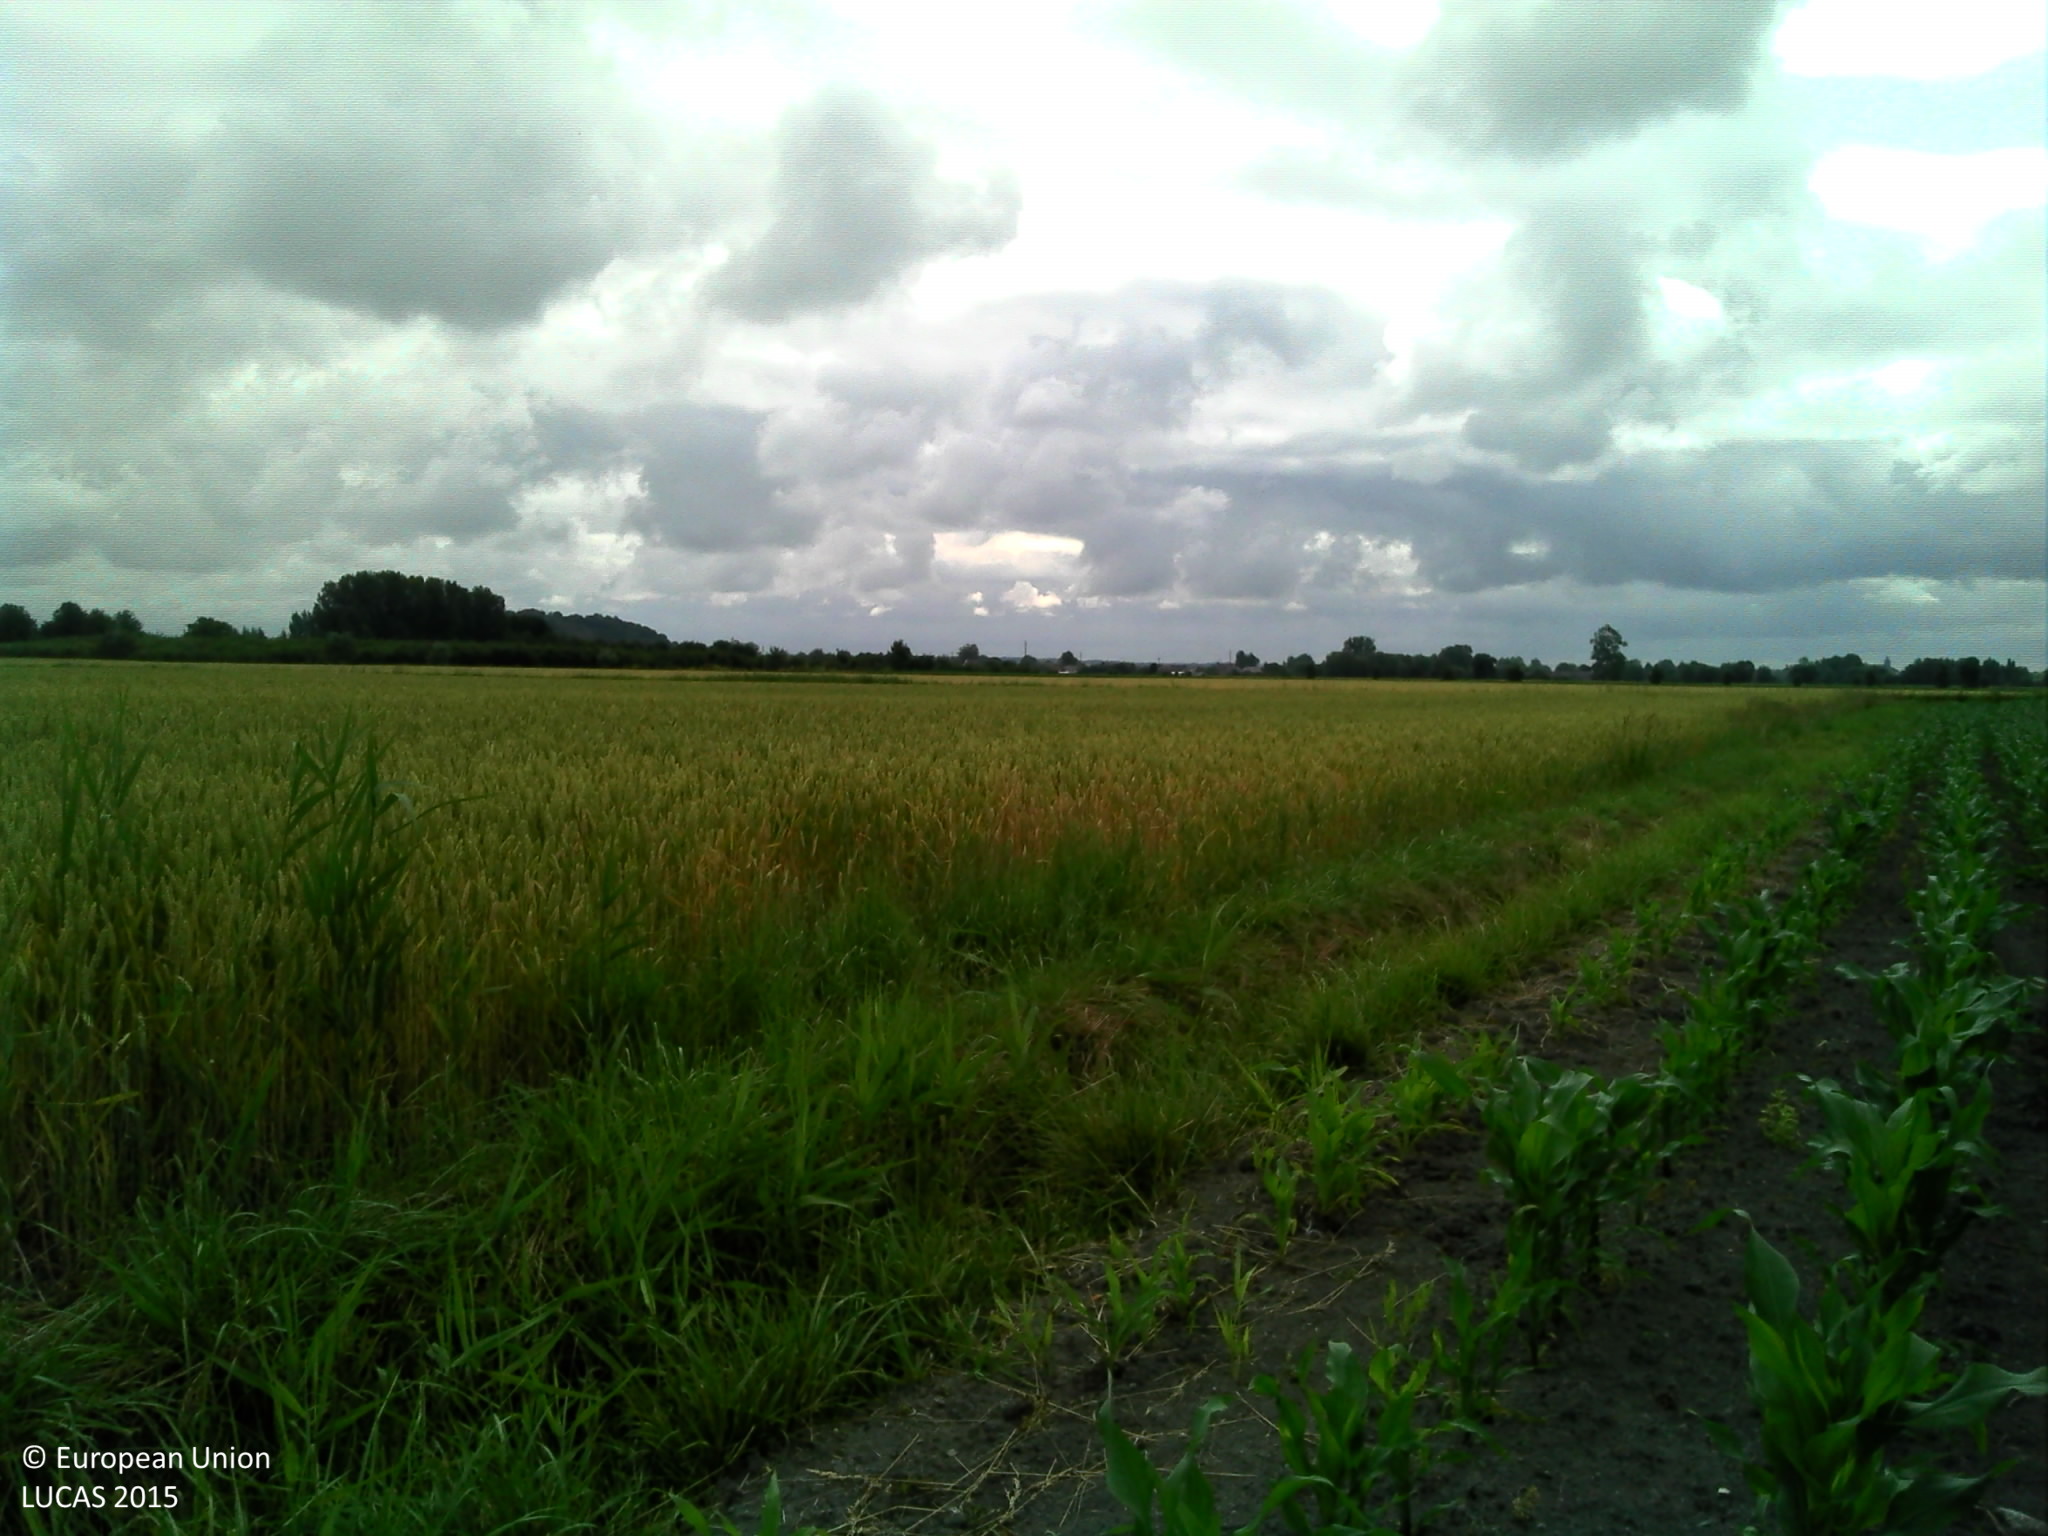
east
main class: Cropland
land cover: Maize
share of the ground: 50 - 75 %
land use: Agriculture (excluding fallow land and kitchen gardens)
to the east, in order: Maize; Grass margins; Common wheat; Grass margins; Durum wheat
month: June
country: FR
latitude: 48.5690
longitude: -1.8011
